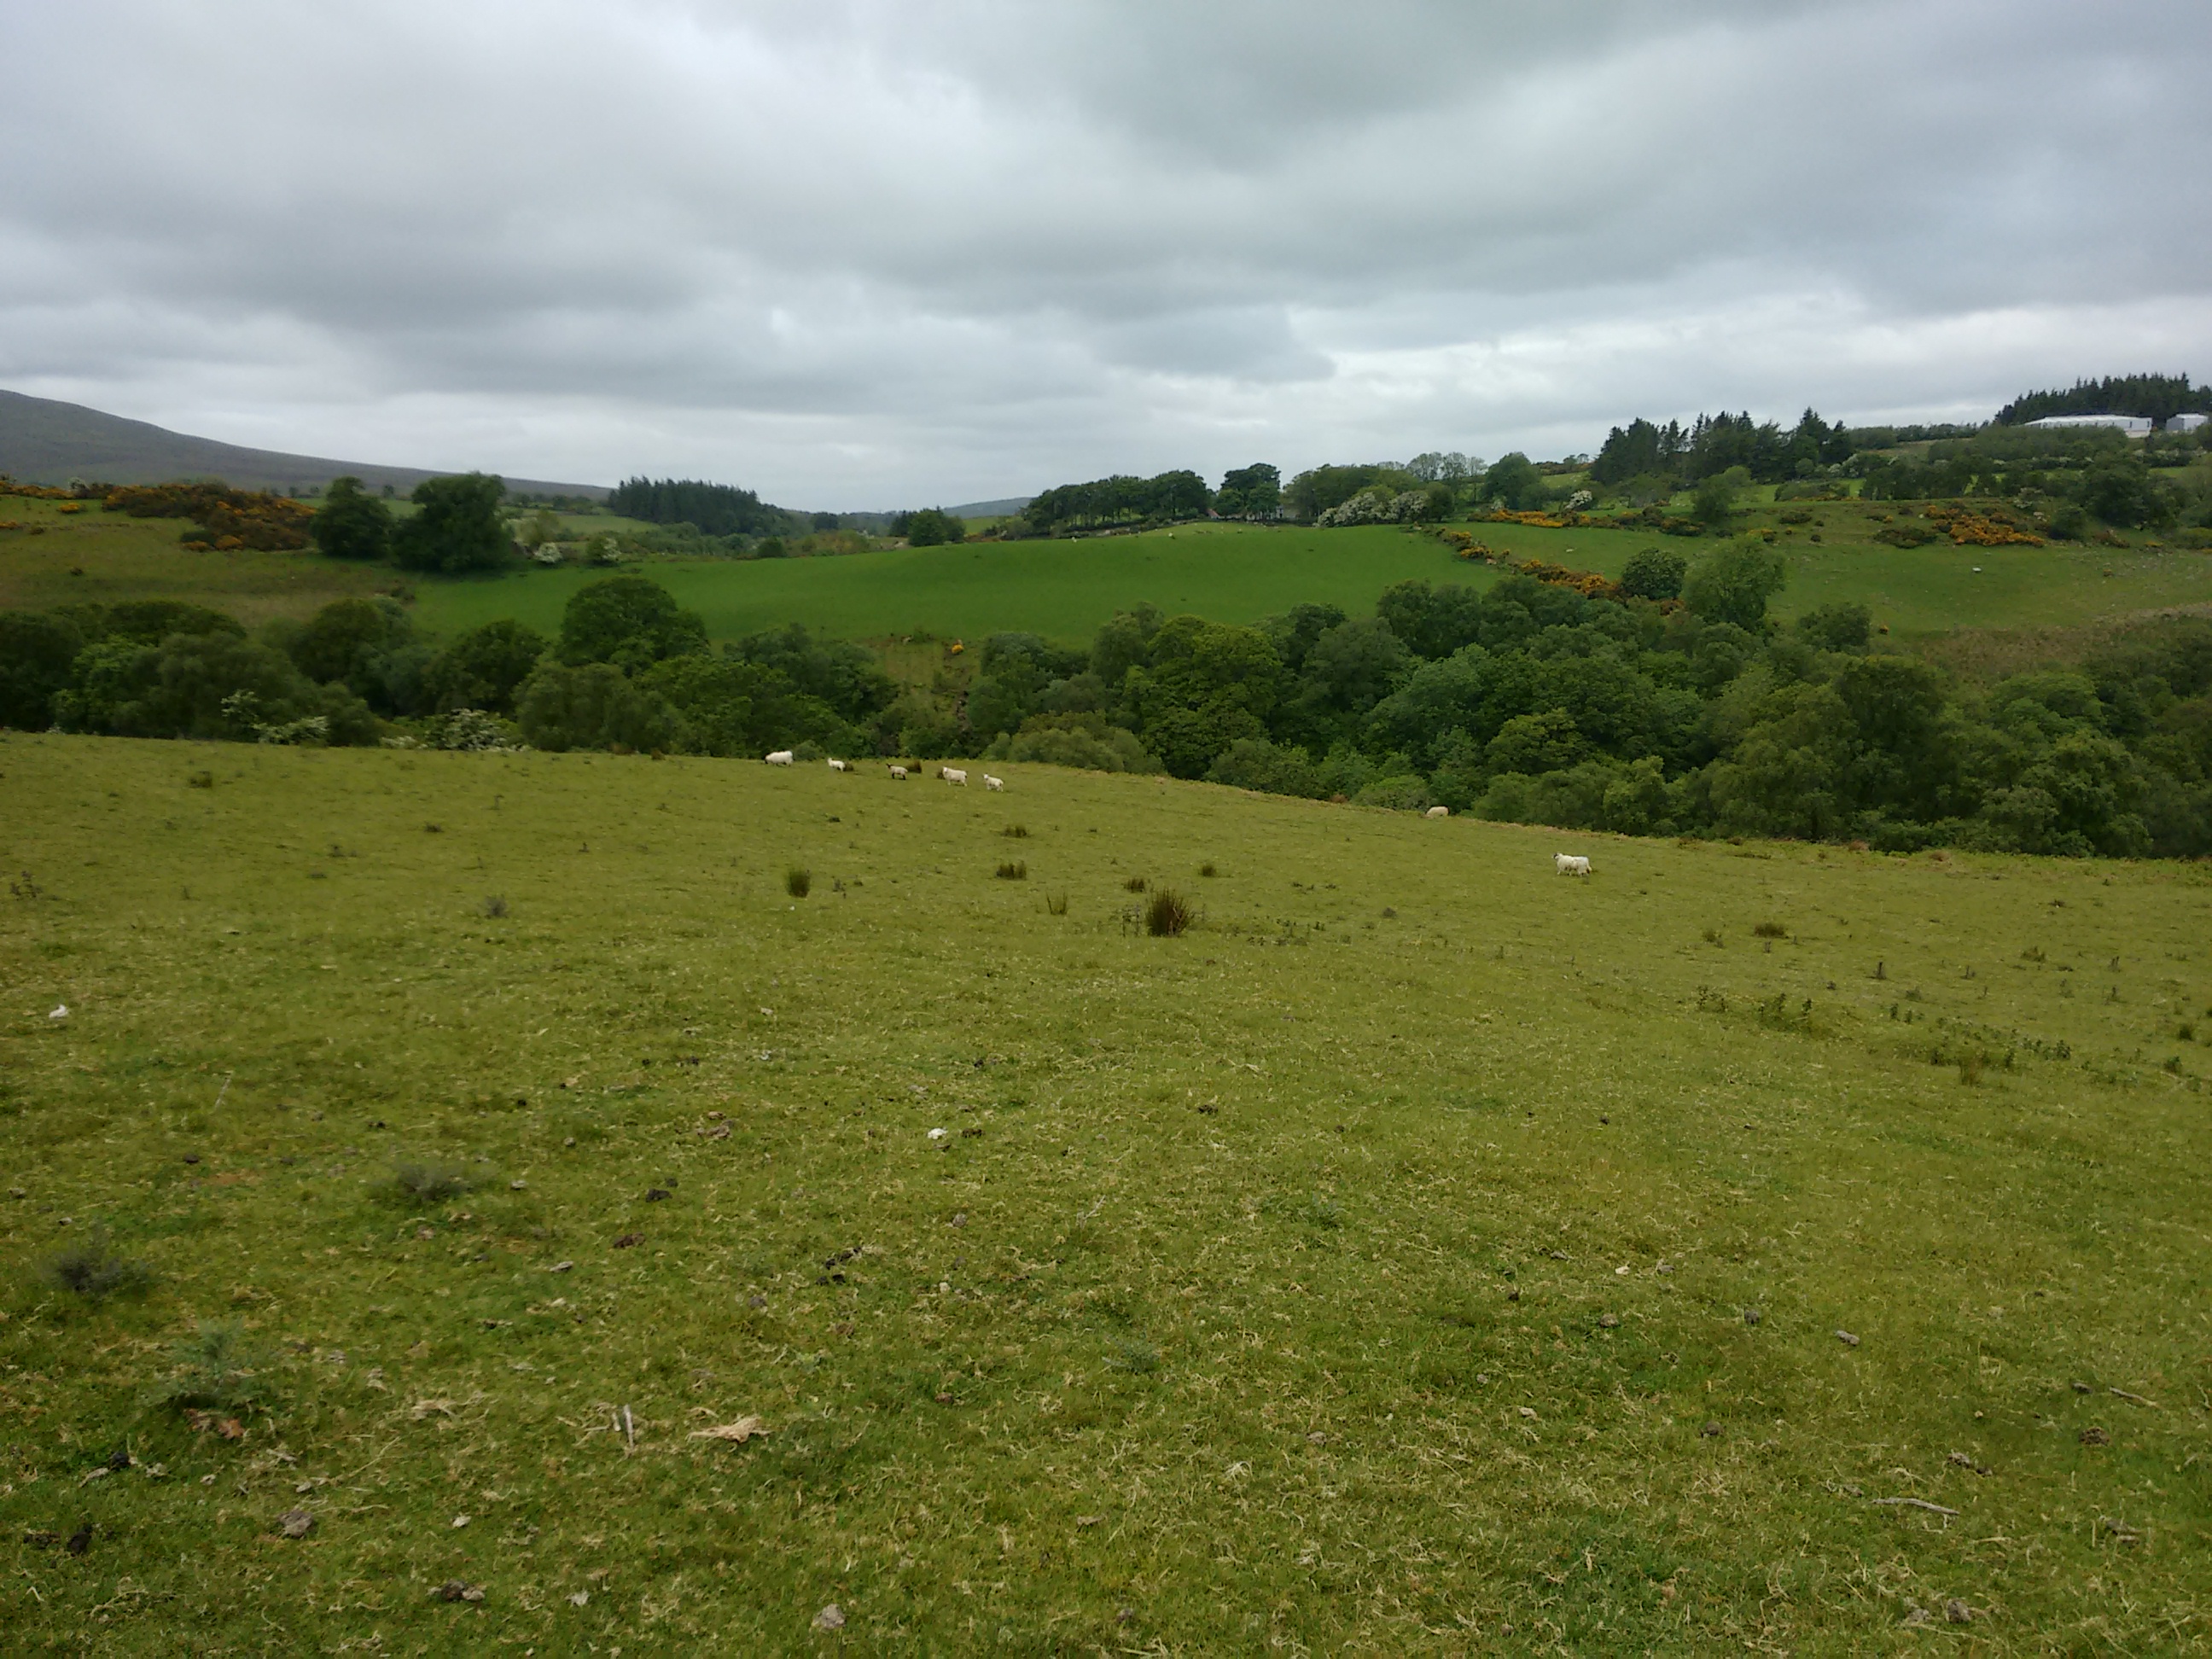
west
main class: Grassland
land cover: Grassland without tree/shrub cover
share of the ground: > 75 %
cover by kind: herbaceous plants 100 %
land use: Agriculture (excluding fallow land and kitchen gardens)
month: June
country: GB
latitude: 54.8808
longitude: -6.9550
